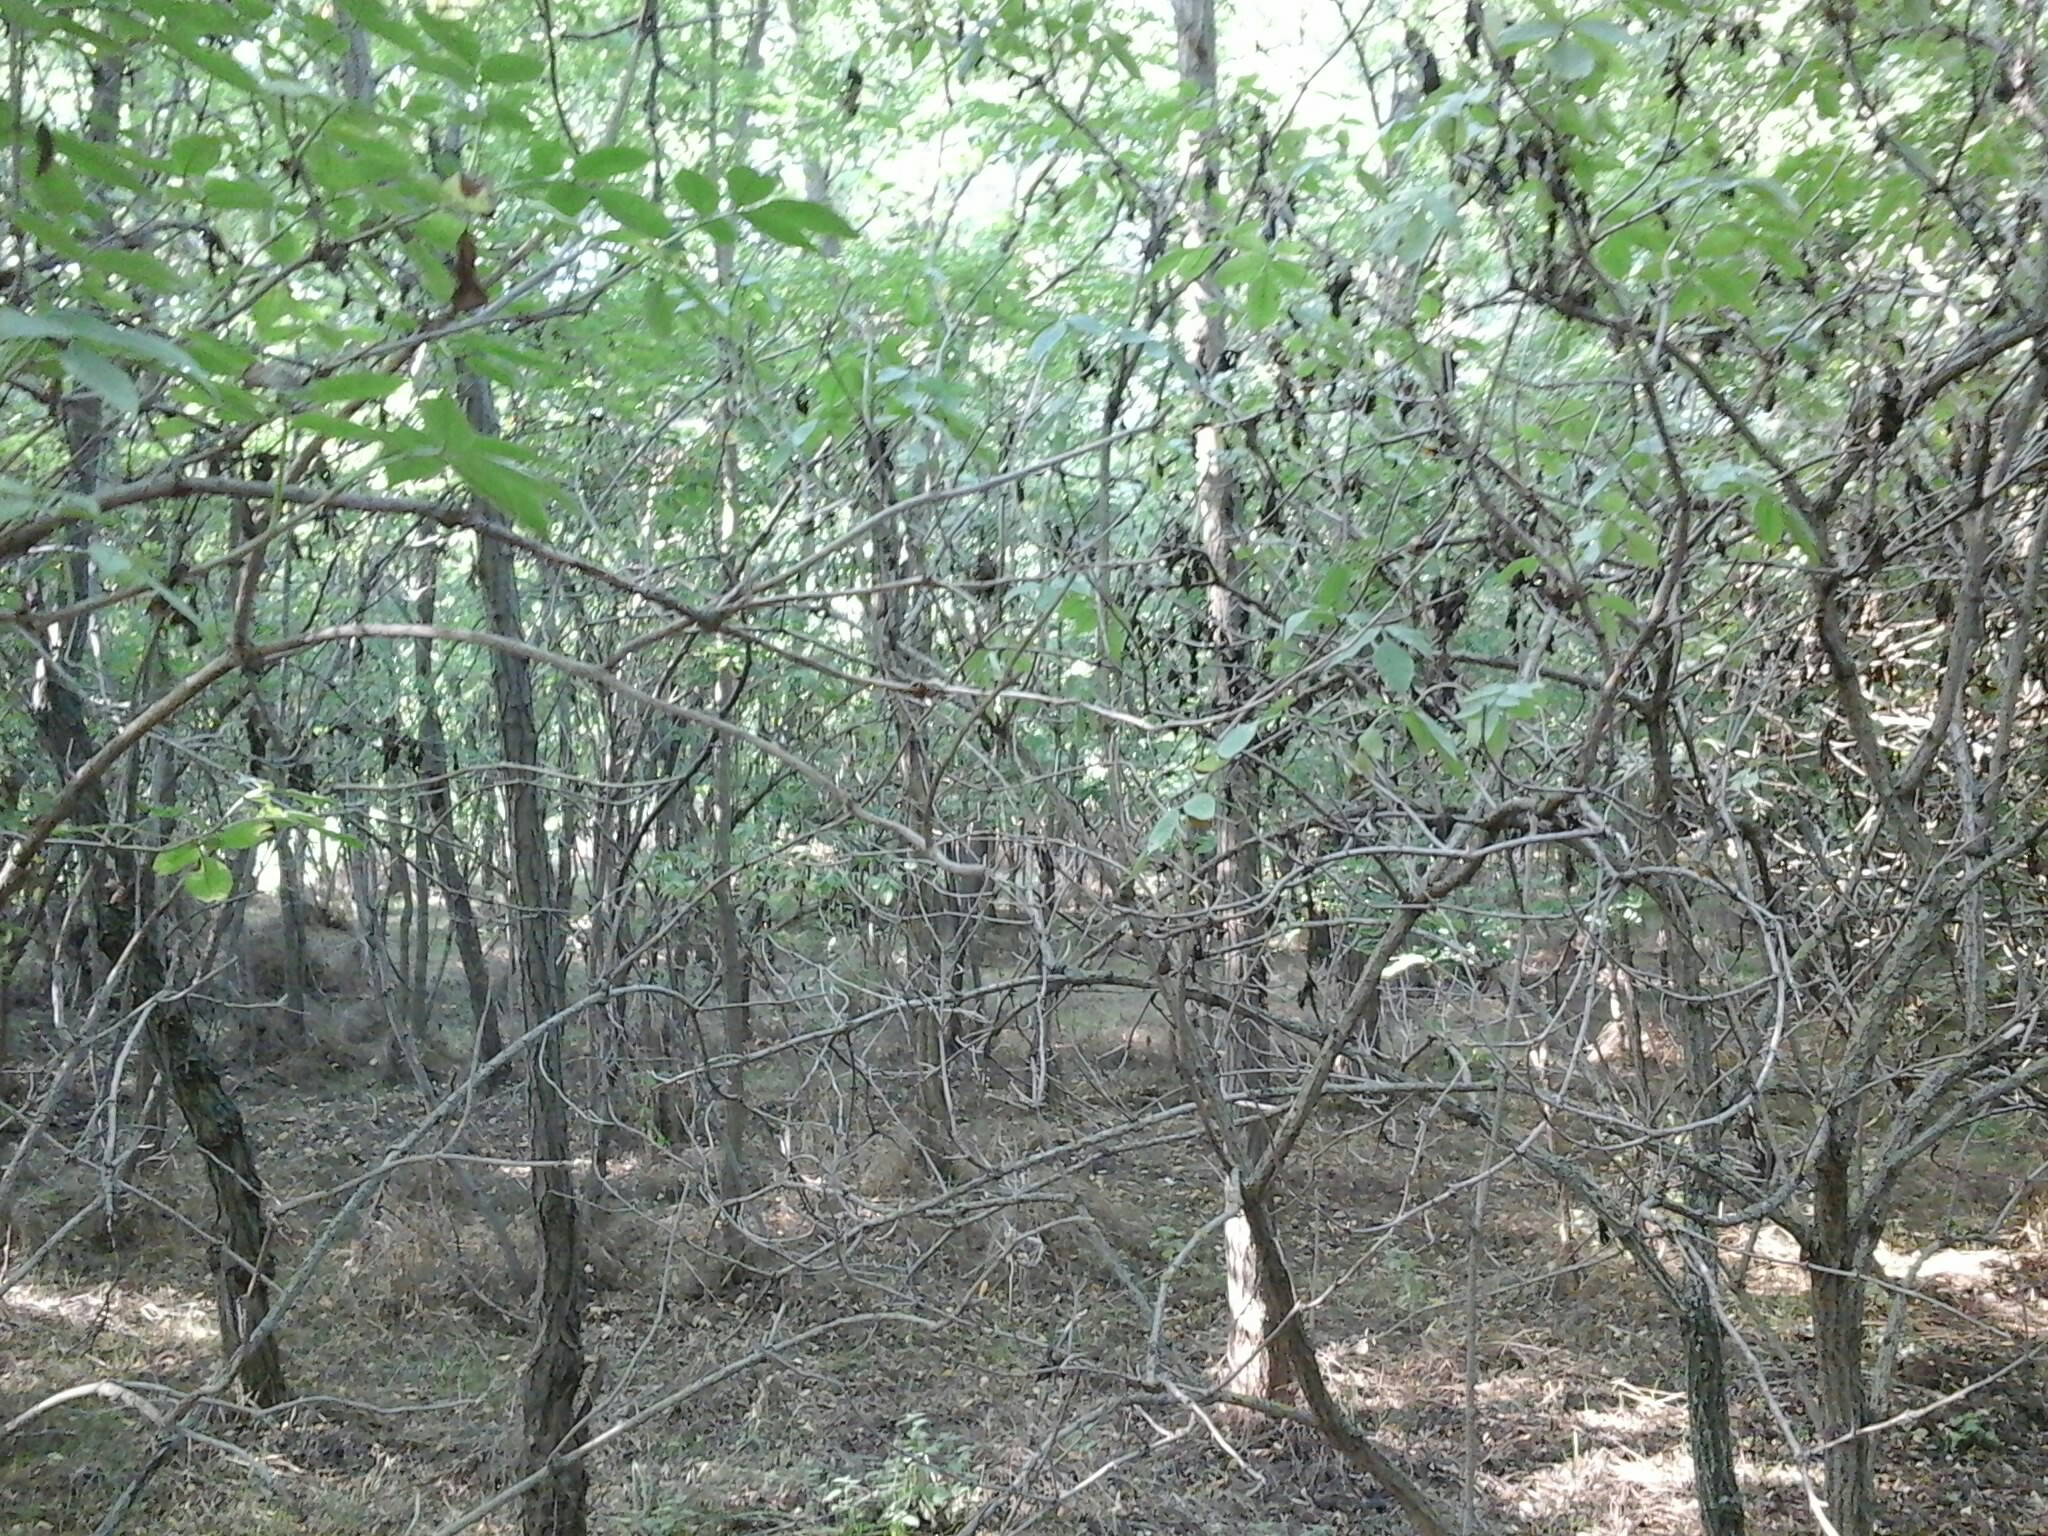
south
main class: Woodland
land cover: Broadleaved woodland
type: exotic forest
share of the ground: > 75 %
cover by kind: broadleaved forest trees 95 %, herbaceous plants 5 %
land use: Forestry
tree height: > 5 m
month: August
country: HU
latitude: 47.4853
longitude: 17.9334
